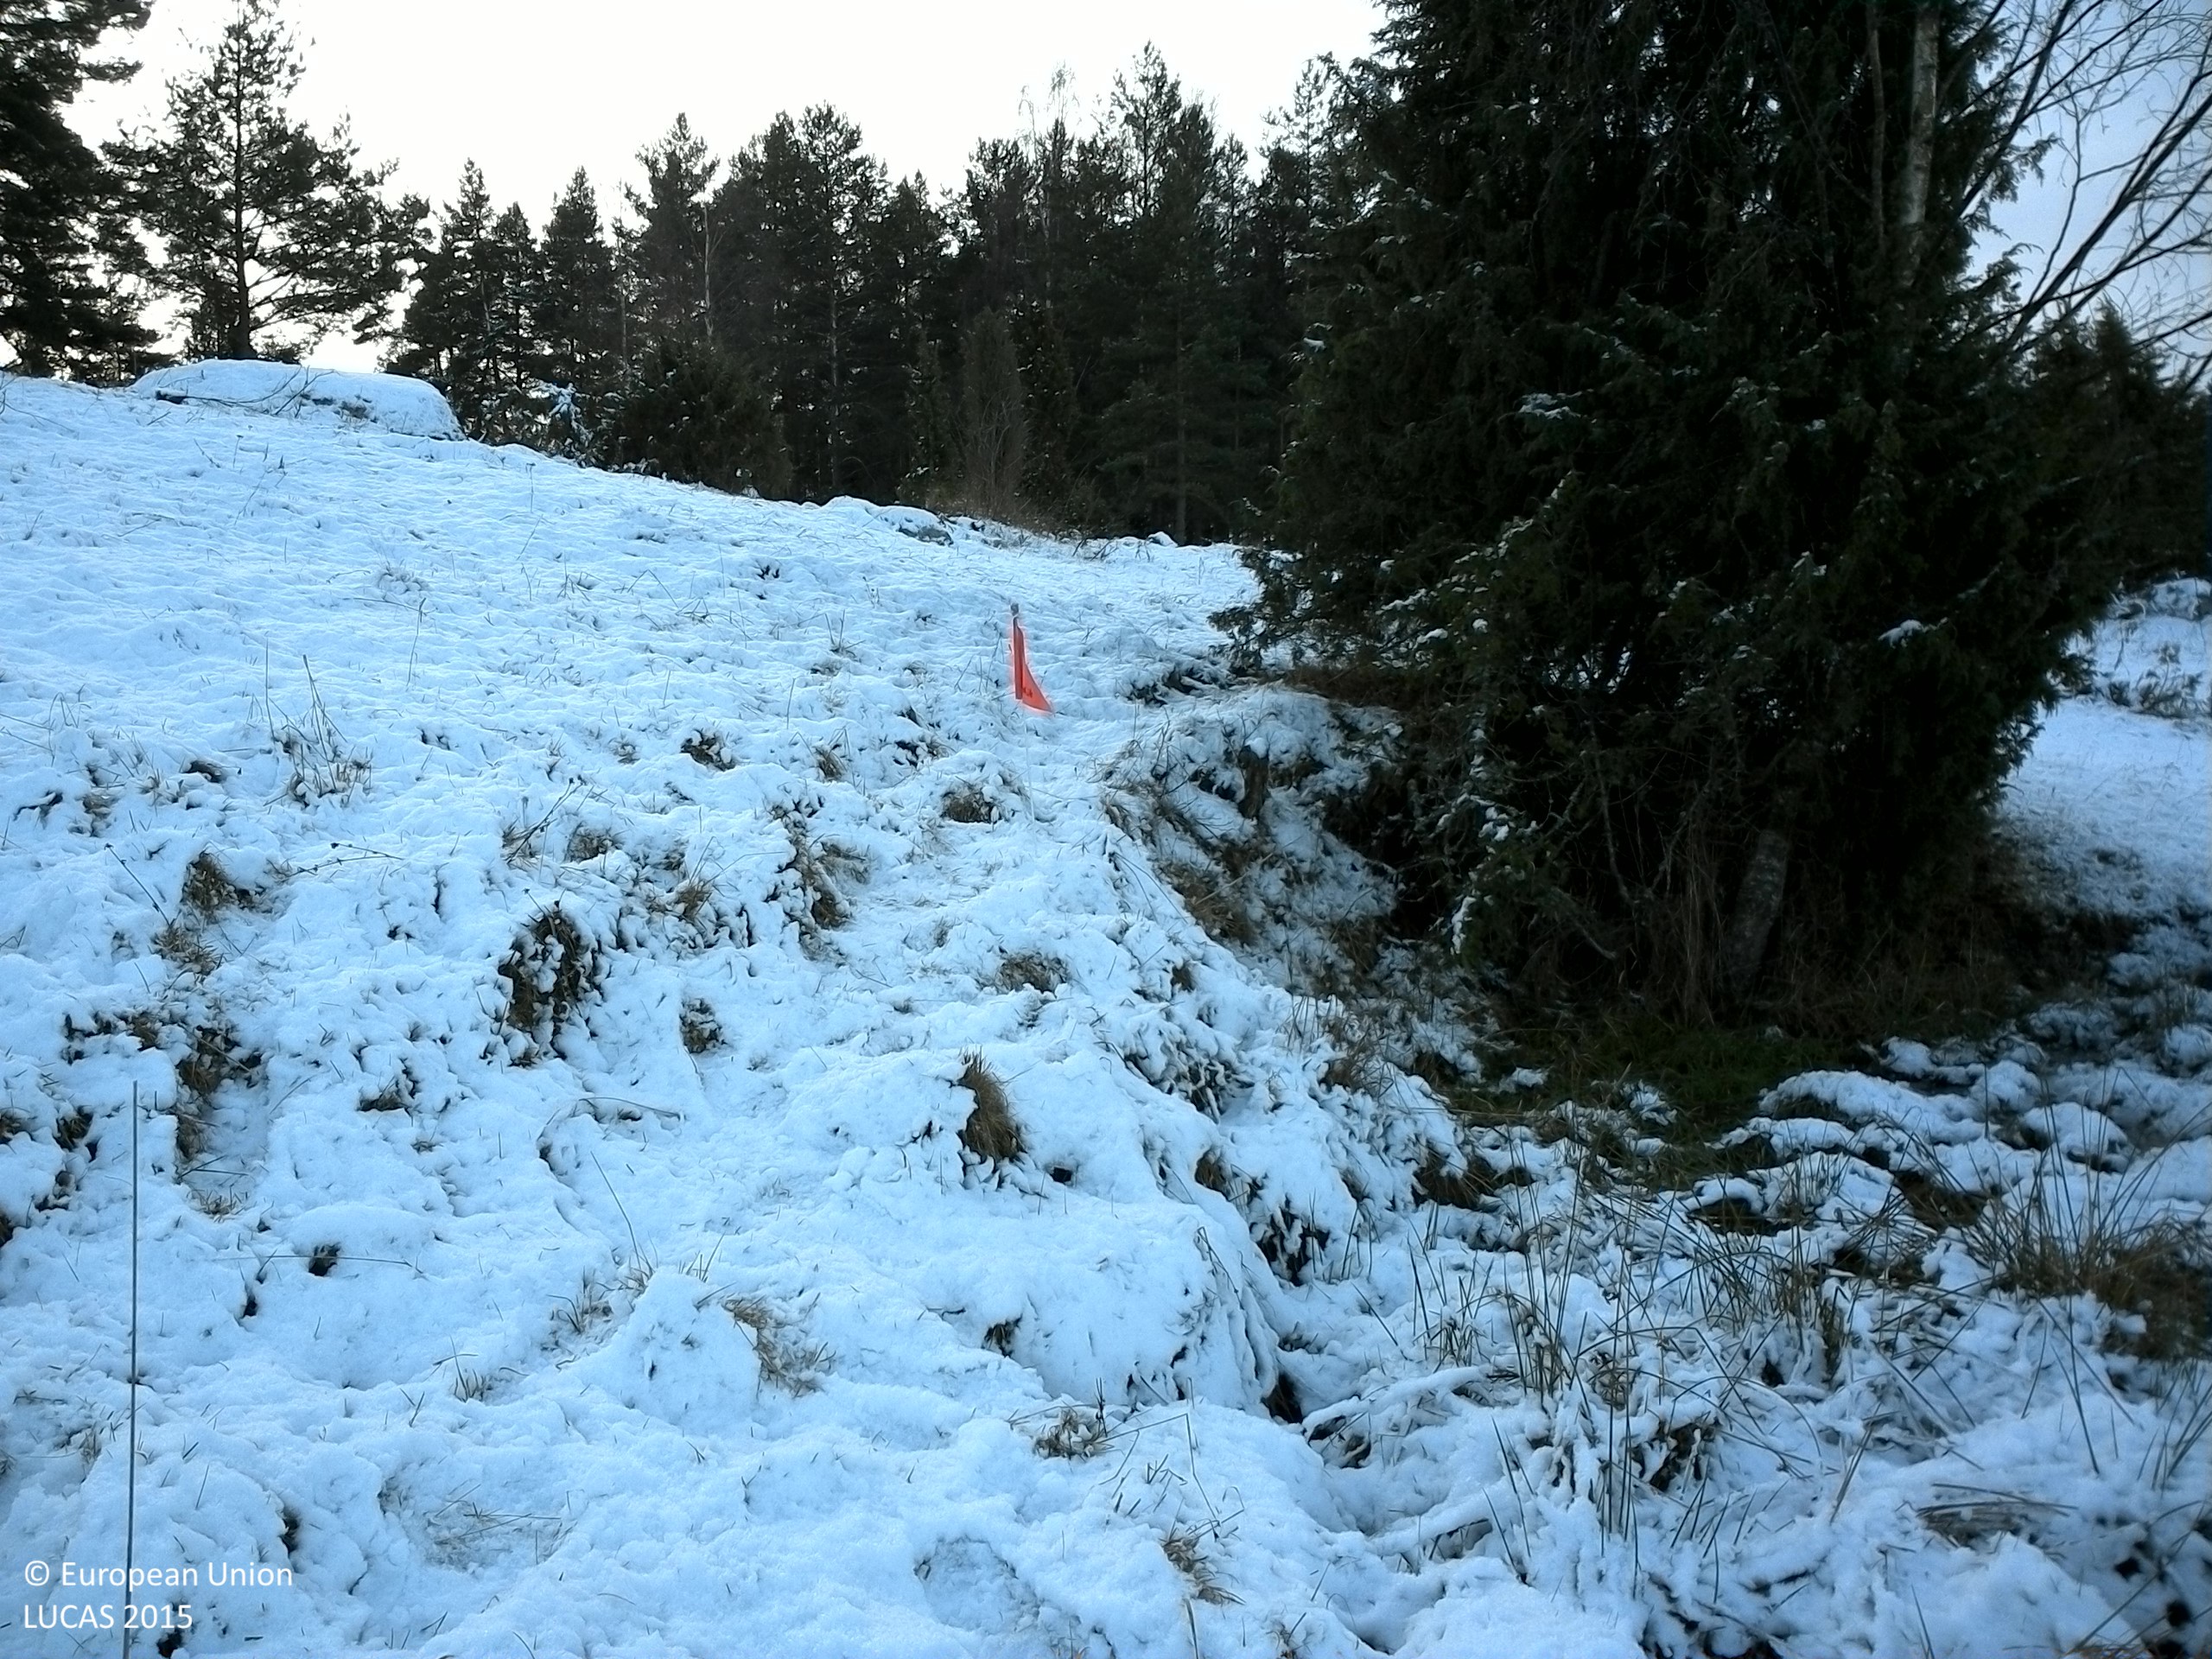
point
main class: Grassland
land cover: Grassland with sparse tree/shrub cover
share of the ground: > 75 %
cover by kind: herbaceous plants 90 %, broadleaved forest trees 5 %, shrubs 5 %
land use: Agriculture (excluding fallow land and kitchen gardens)
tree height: > 5 m
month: December
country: SE
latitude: 59.5292
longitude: 16.4099
